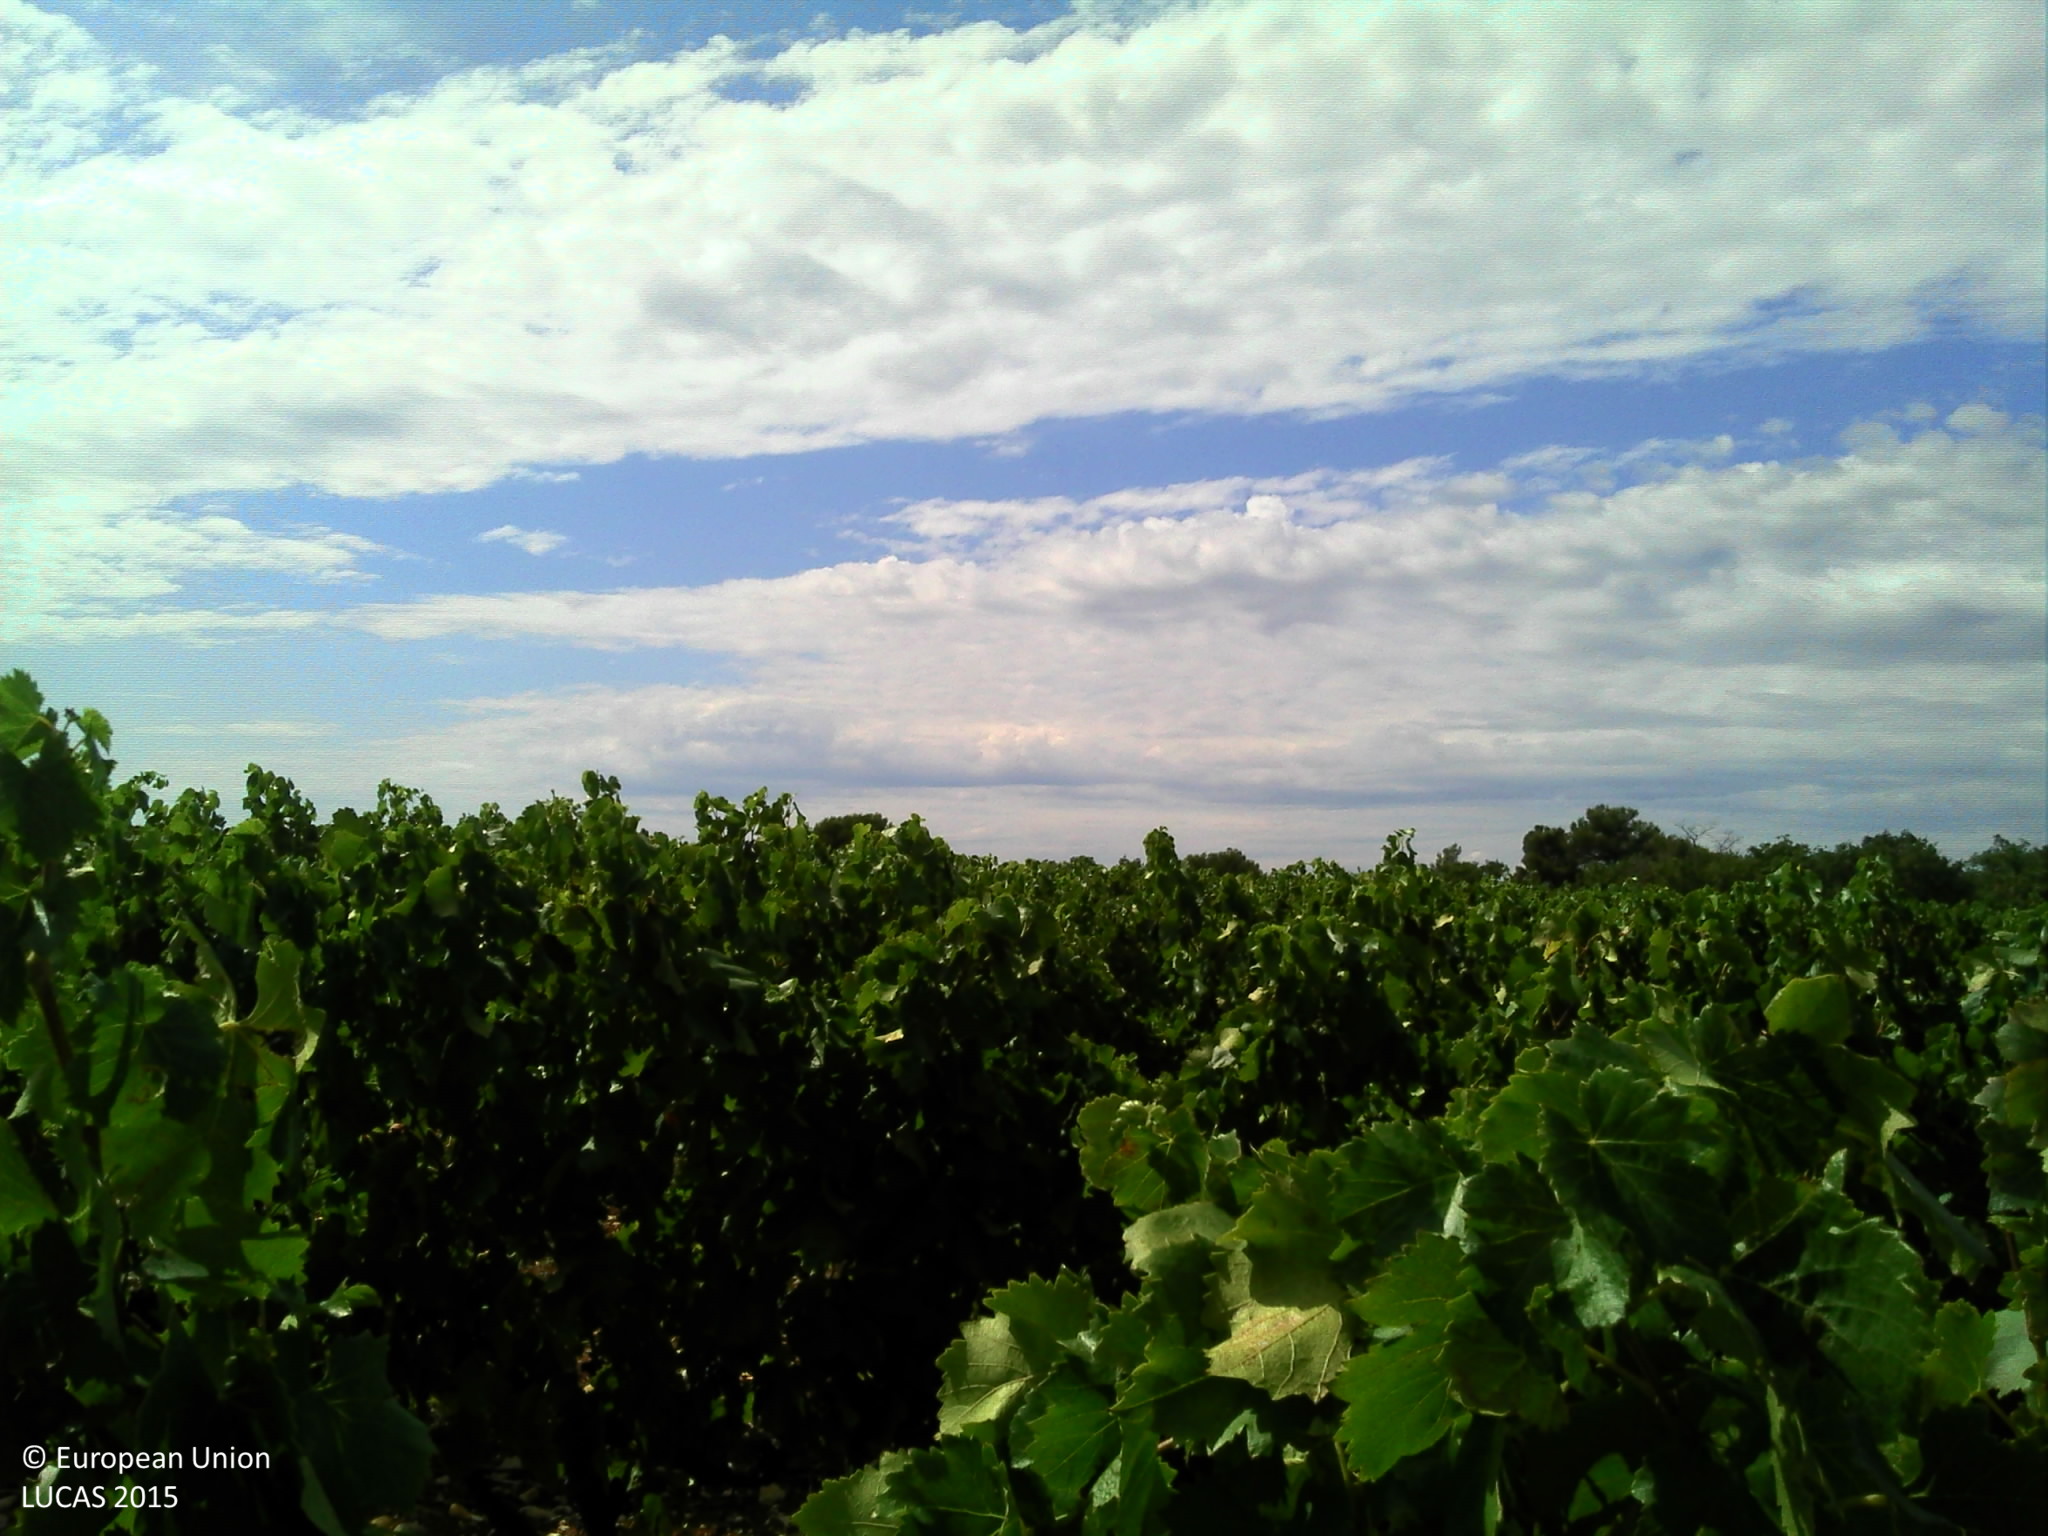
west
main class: Cropland
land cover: Vineyards
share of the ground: 10 - 25 %
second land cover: Other bare soil
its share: > 75 %
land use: Agriculture (excluding fallow land and kitchen gardens)
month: September
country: FR
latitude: 44.3206
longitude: 5.0046
